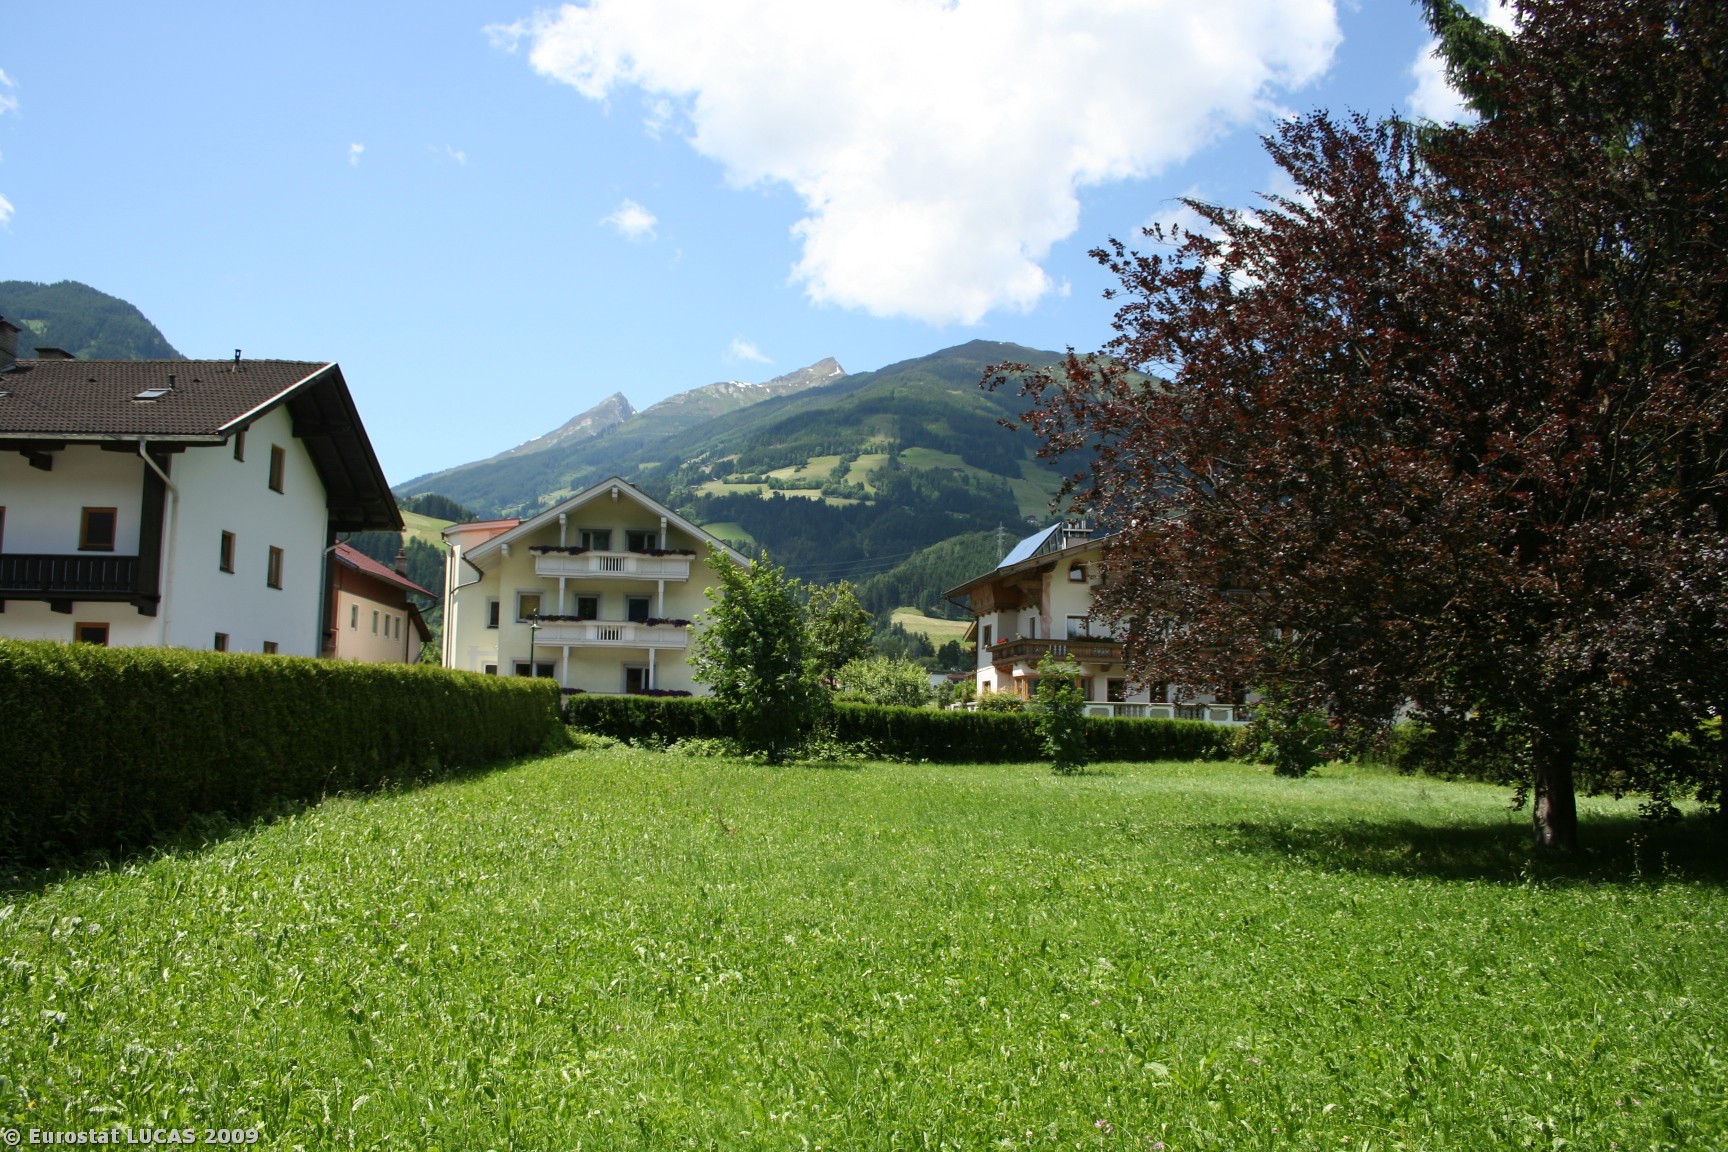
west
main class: Grassland
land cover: Grassland with sparse tree/shrub cover
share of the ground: > 75 %
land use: Agriculture (excluding fallow land and kitchen gardens)
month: June
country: AT
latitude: 47.3256
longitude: 11.8641
